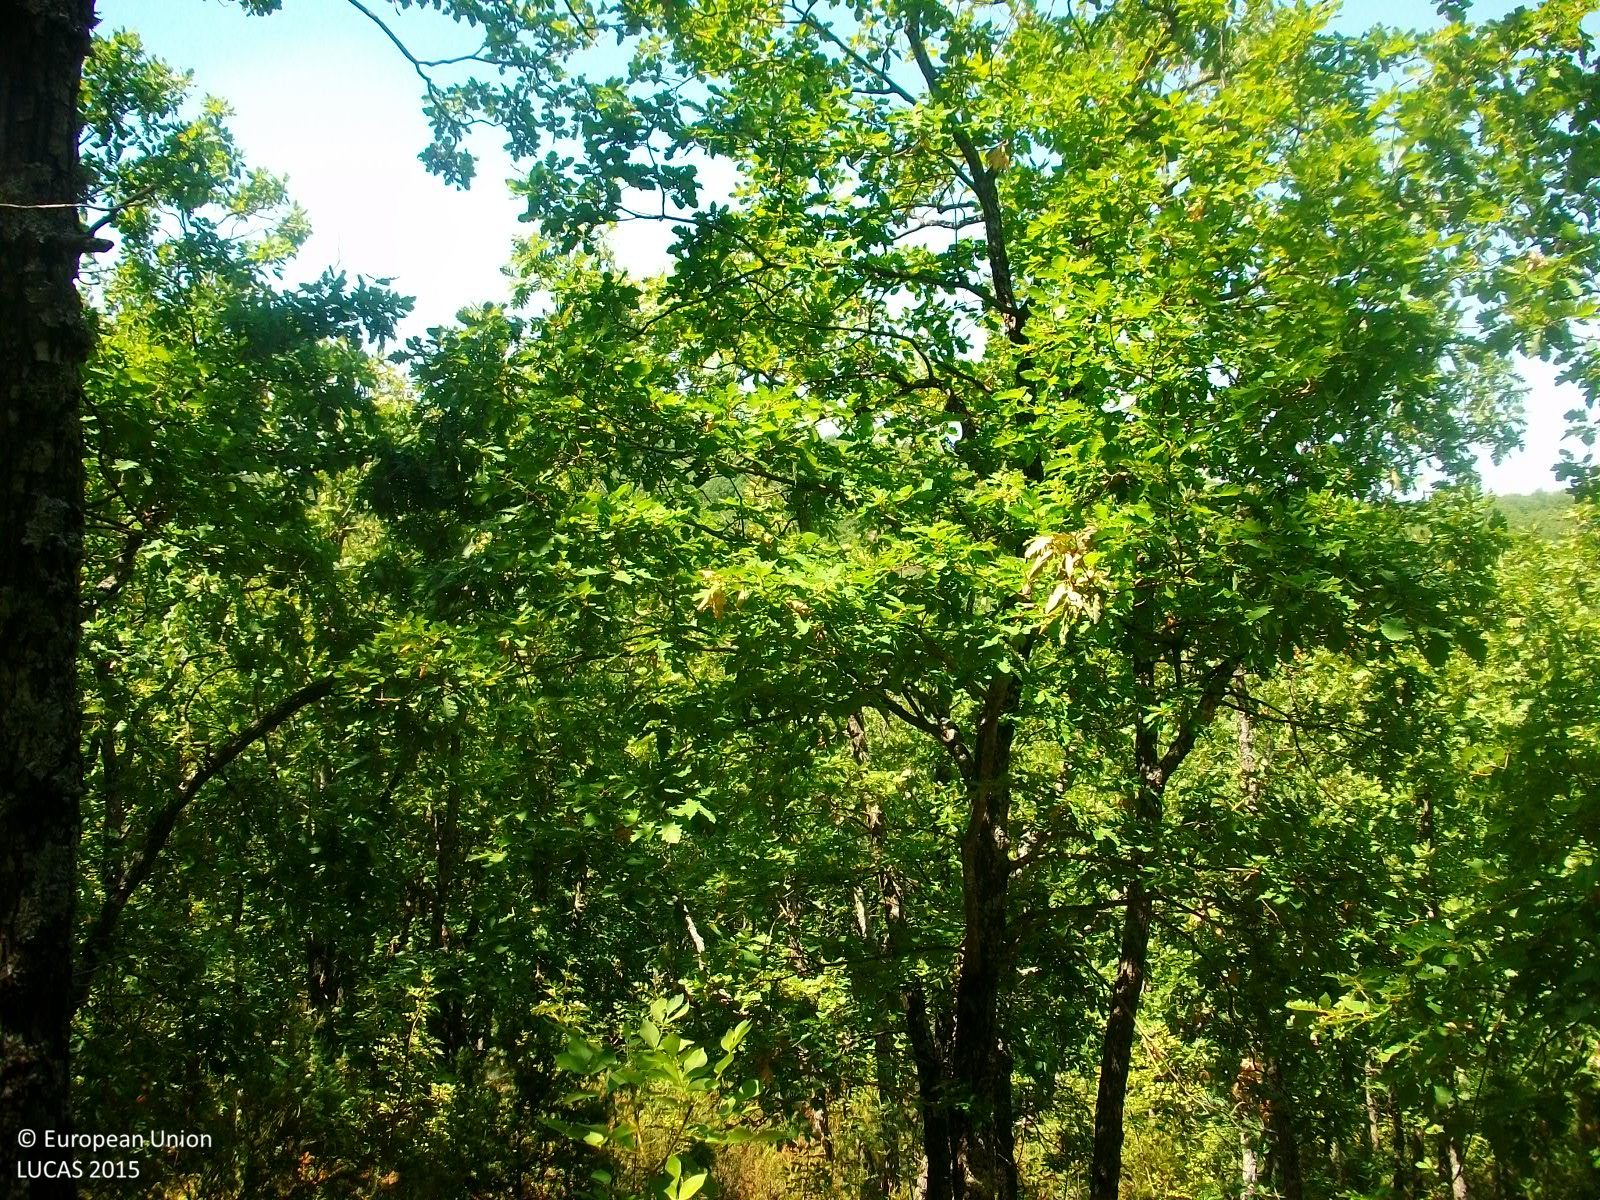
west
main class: Woodland
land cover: Broadleaved woodland
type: thermophilous deciduous forest
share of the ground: > 75 %
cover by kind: broadleaved forest trees 90 %, shrubs 5 %, herbaceous plants 5 %
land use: Forestry
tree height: > 5 m
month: August
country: GR
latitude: 41.2554
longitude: 26.2654
